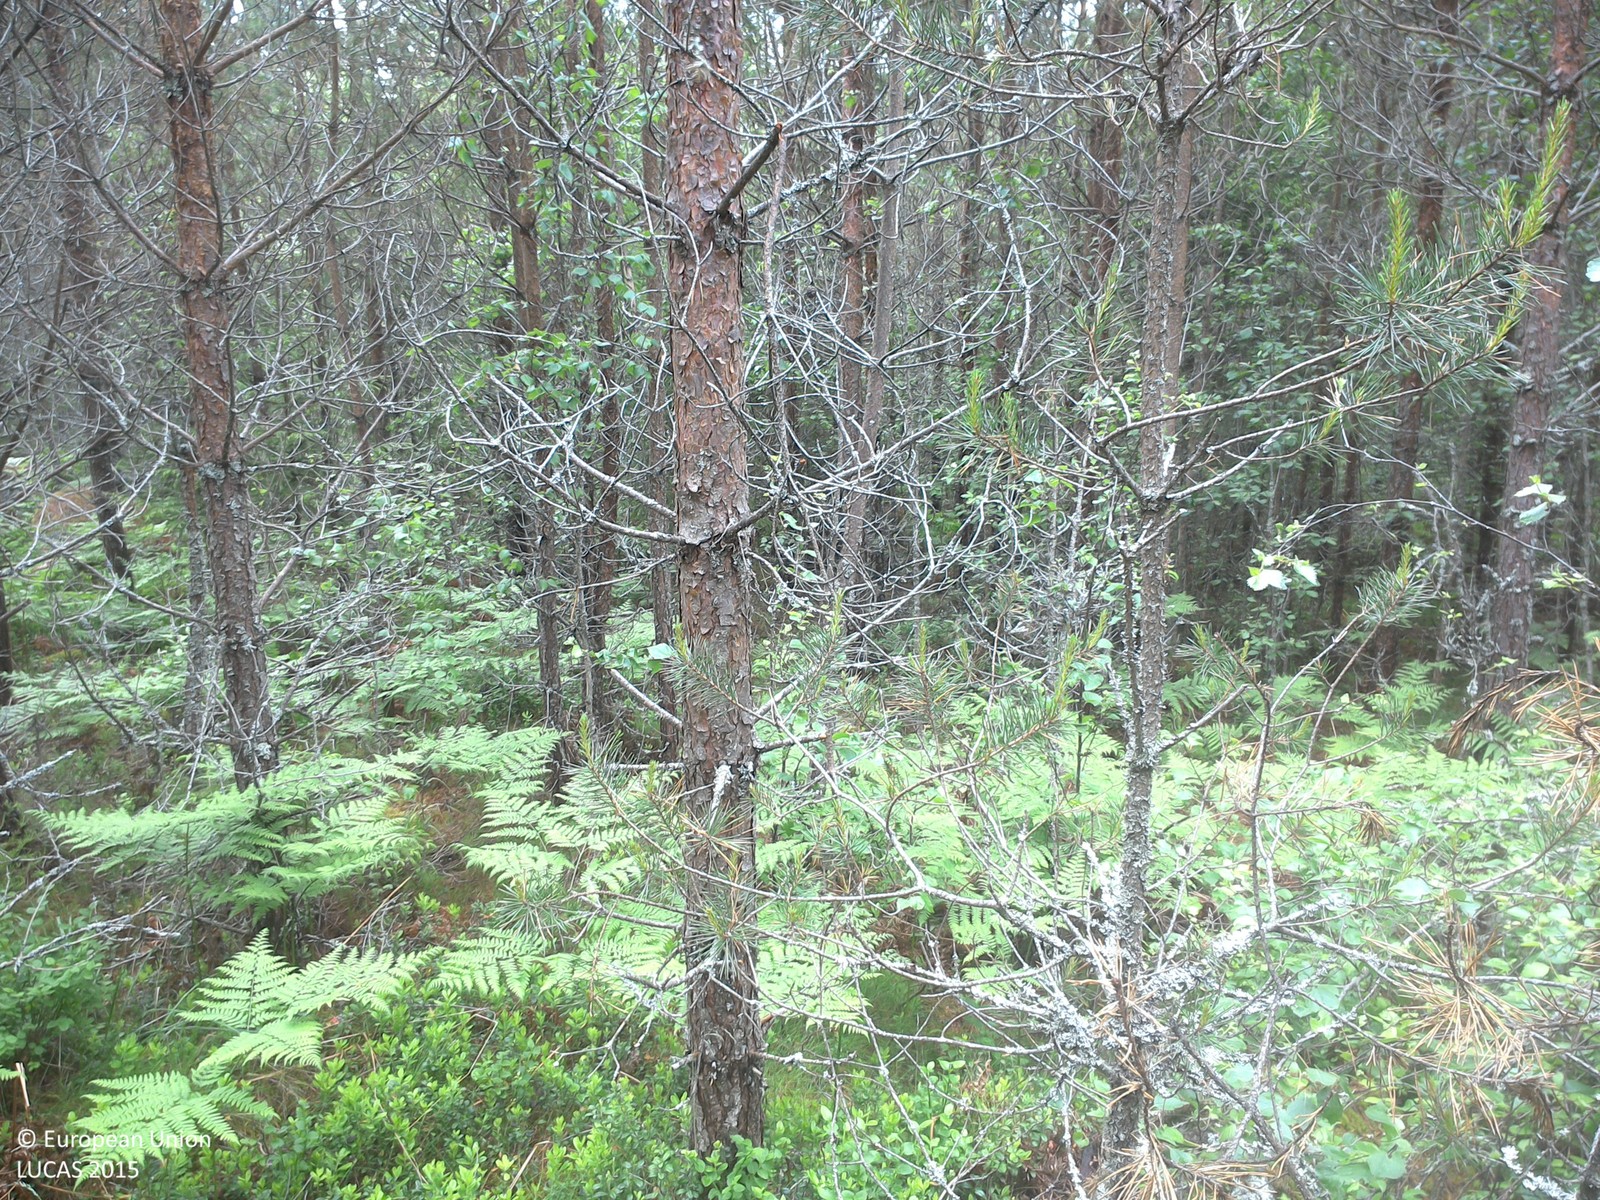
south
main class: Woodland
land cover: Pine dominated coniferous woodland
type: boreal forest
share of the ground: 50 - 75 %
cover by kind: coniferous forest trees 70 %, lichens and mosses 25 %, herbaceous plants 5 %
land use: Forestry
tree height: > 5 m
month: June
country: SE
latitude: 58.1217
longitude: 15.5807
